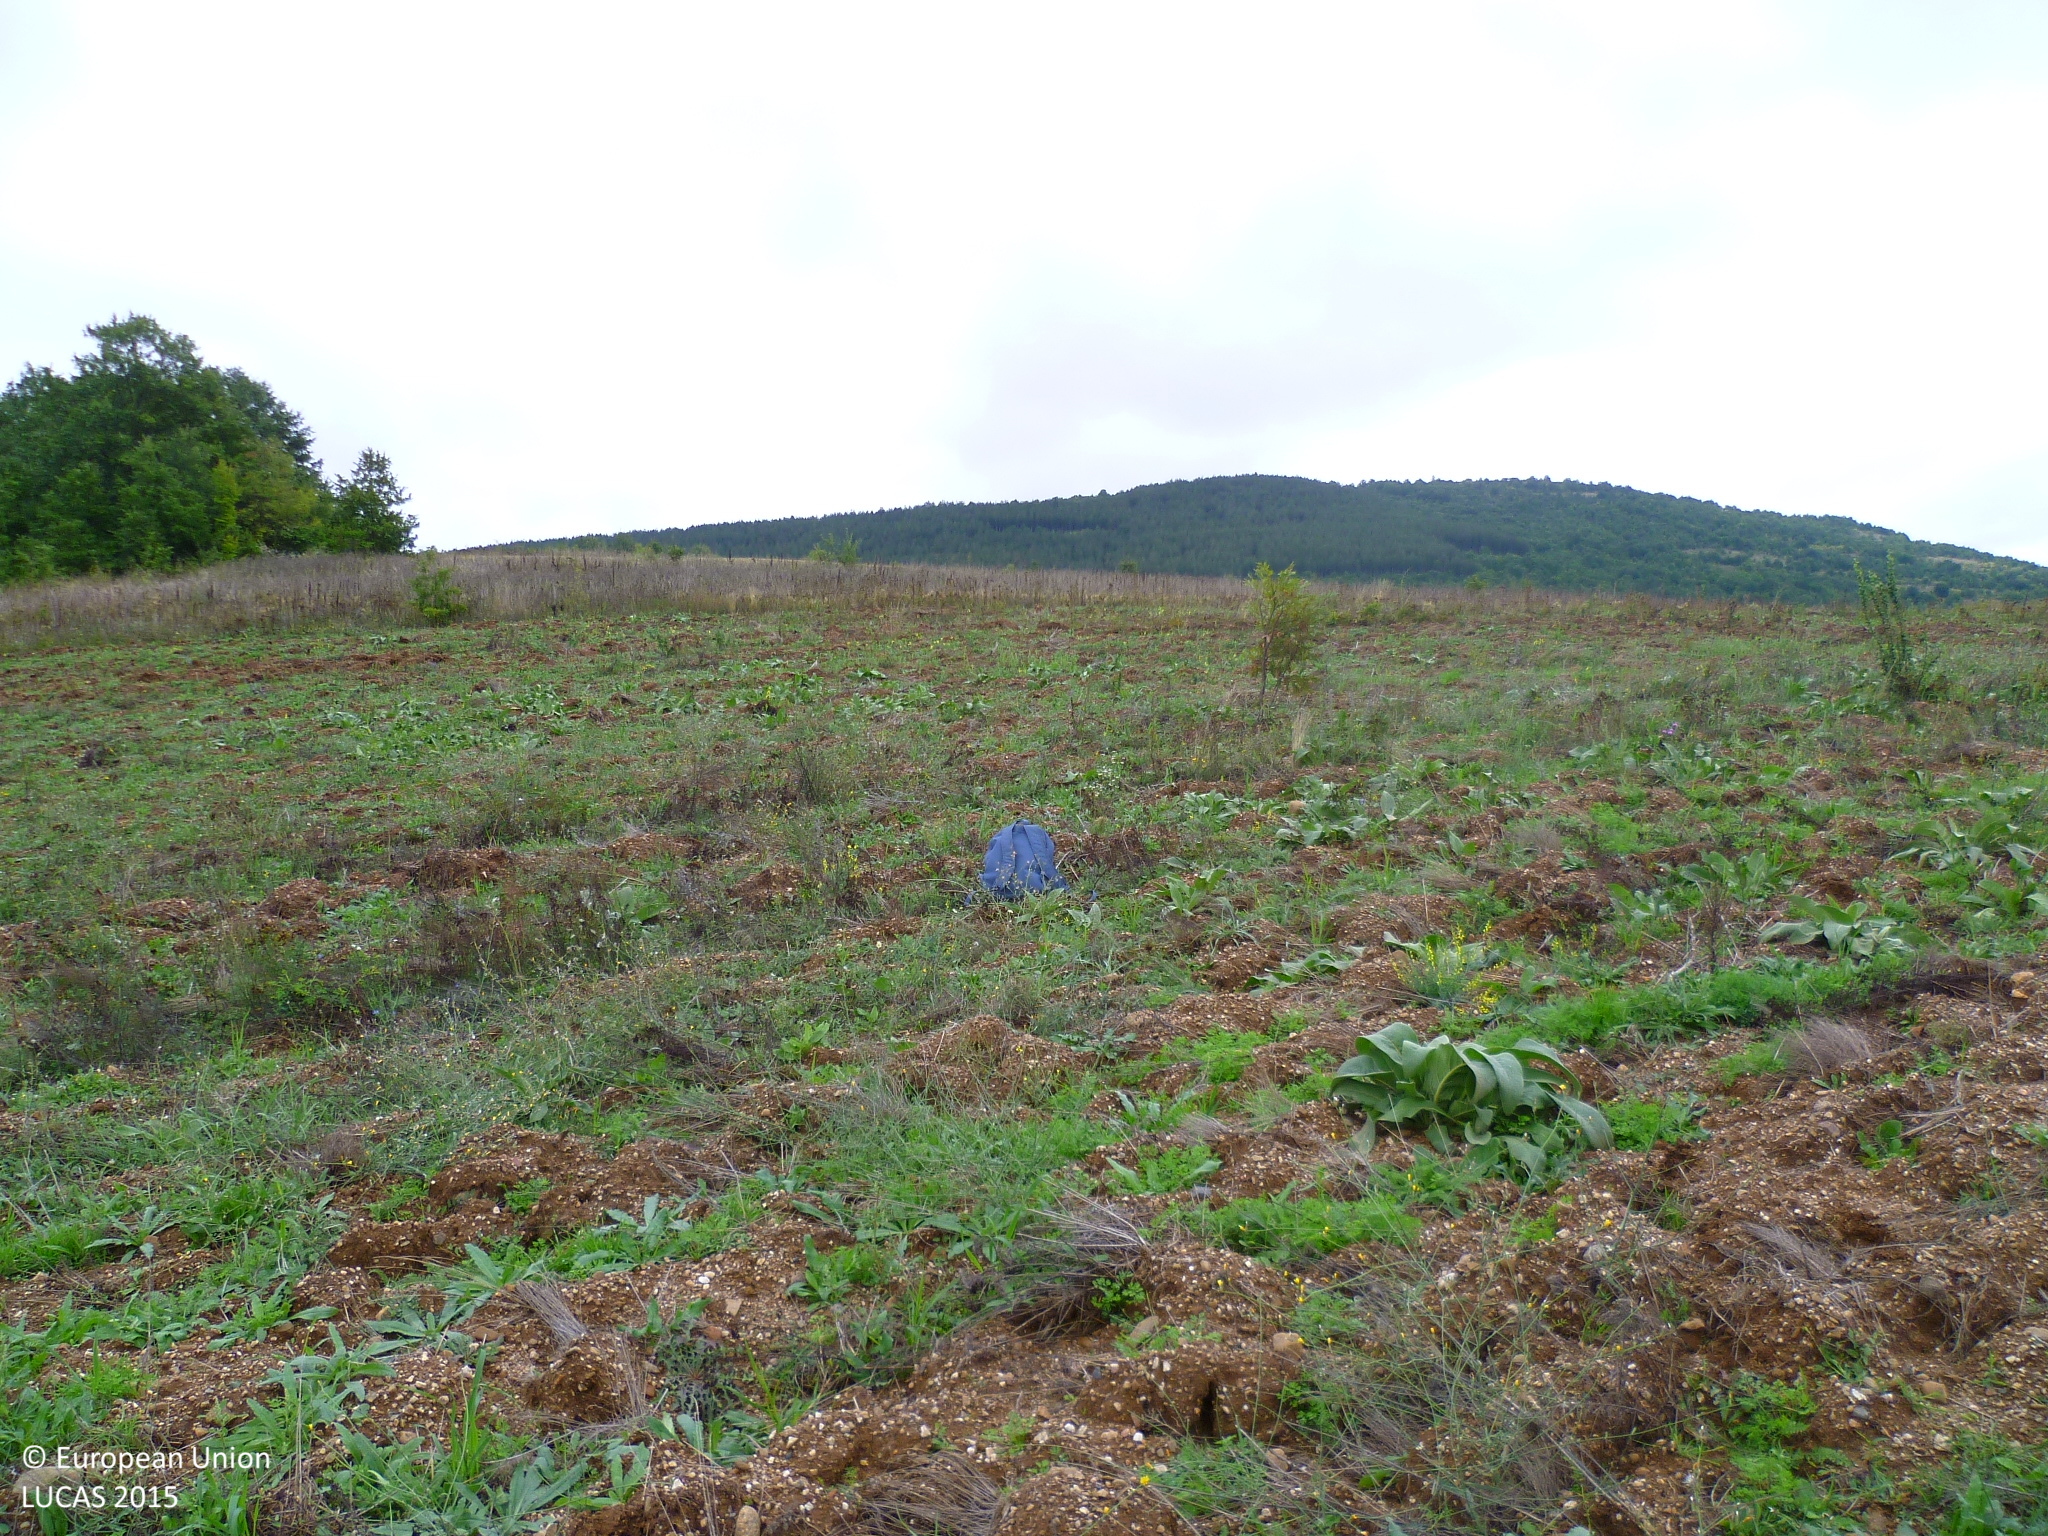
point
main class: Grassland
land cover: Spontaneously vegetated surfaces
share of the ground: 50 - 75 %
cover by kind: herbaceous plants 65 %, unconsolidated bare surface 35 %
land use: Agriculture (excluding fallow land and kitchen gardens)
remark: Harvested field
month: September
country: BG
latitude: 42.6275
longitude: 22.7680
